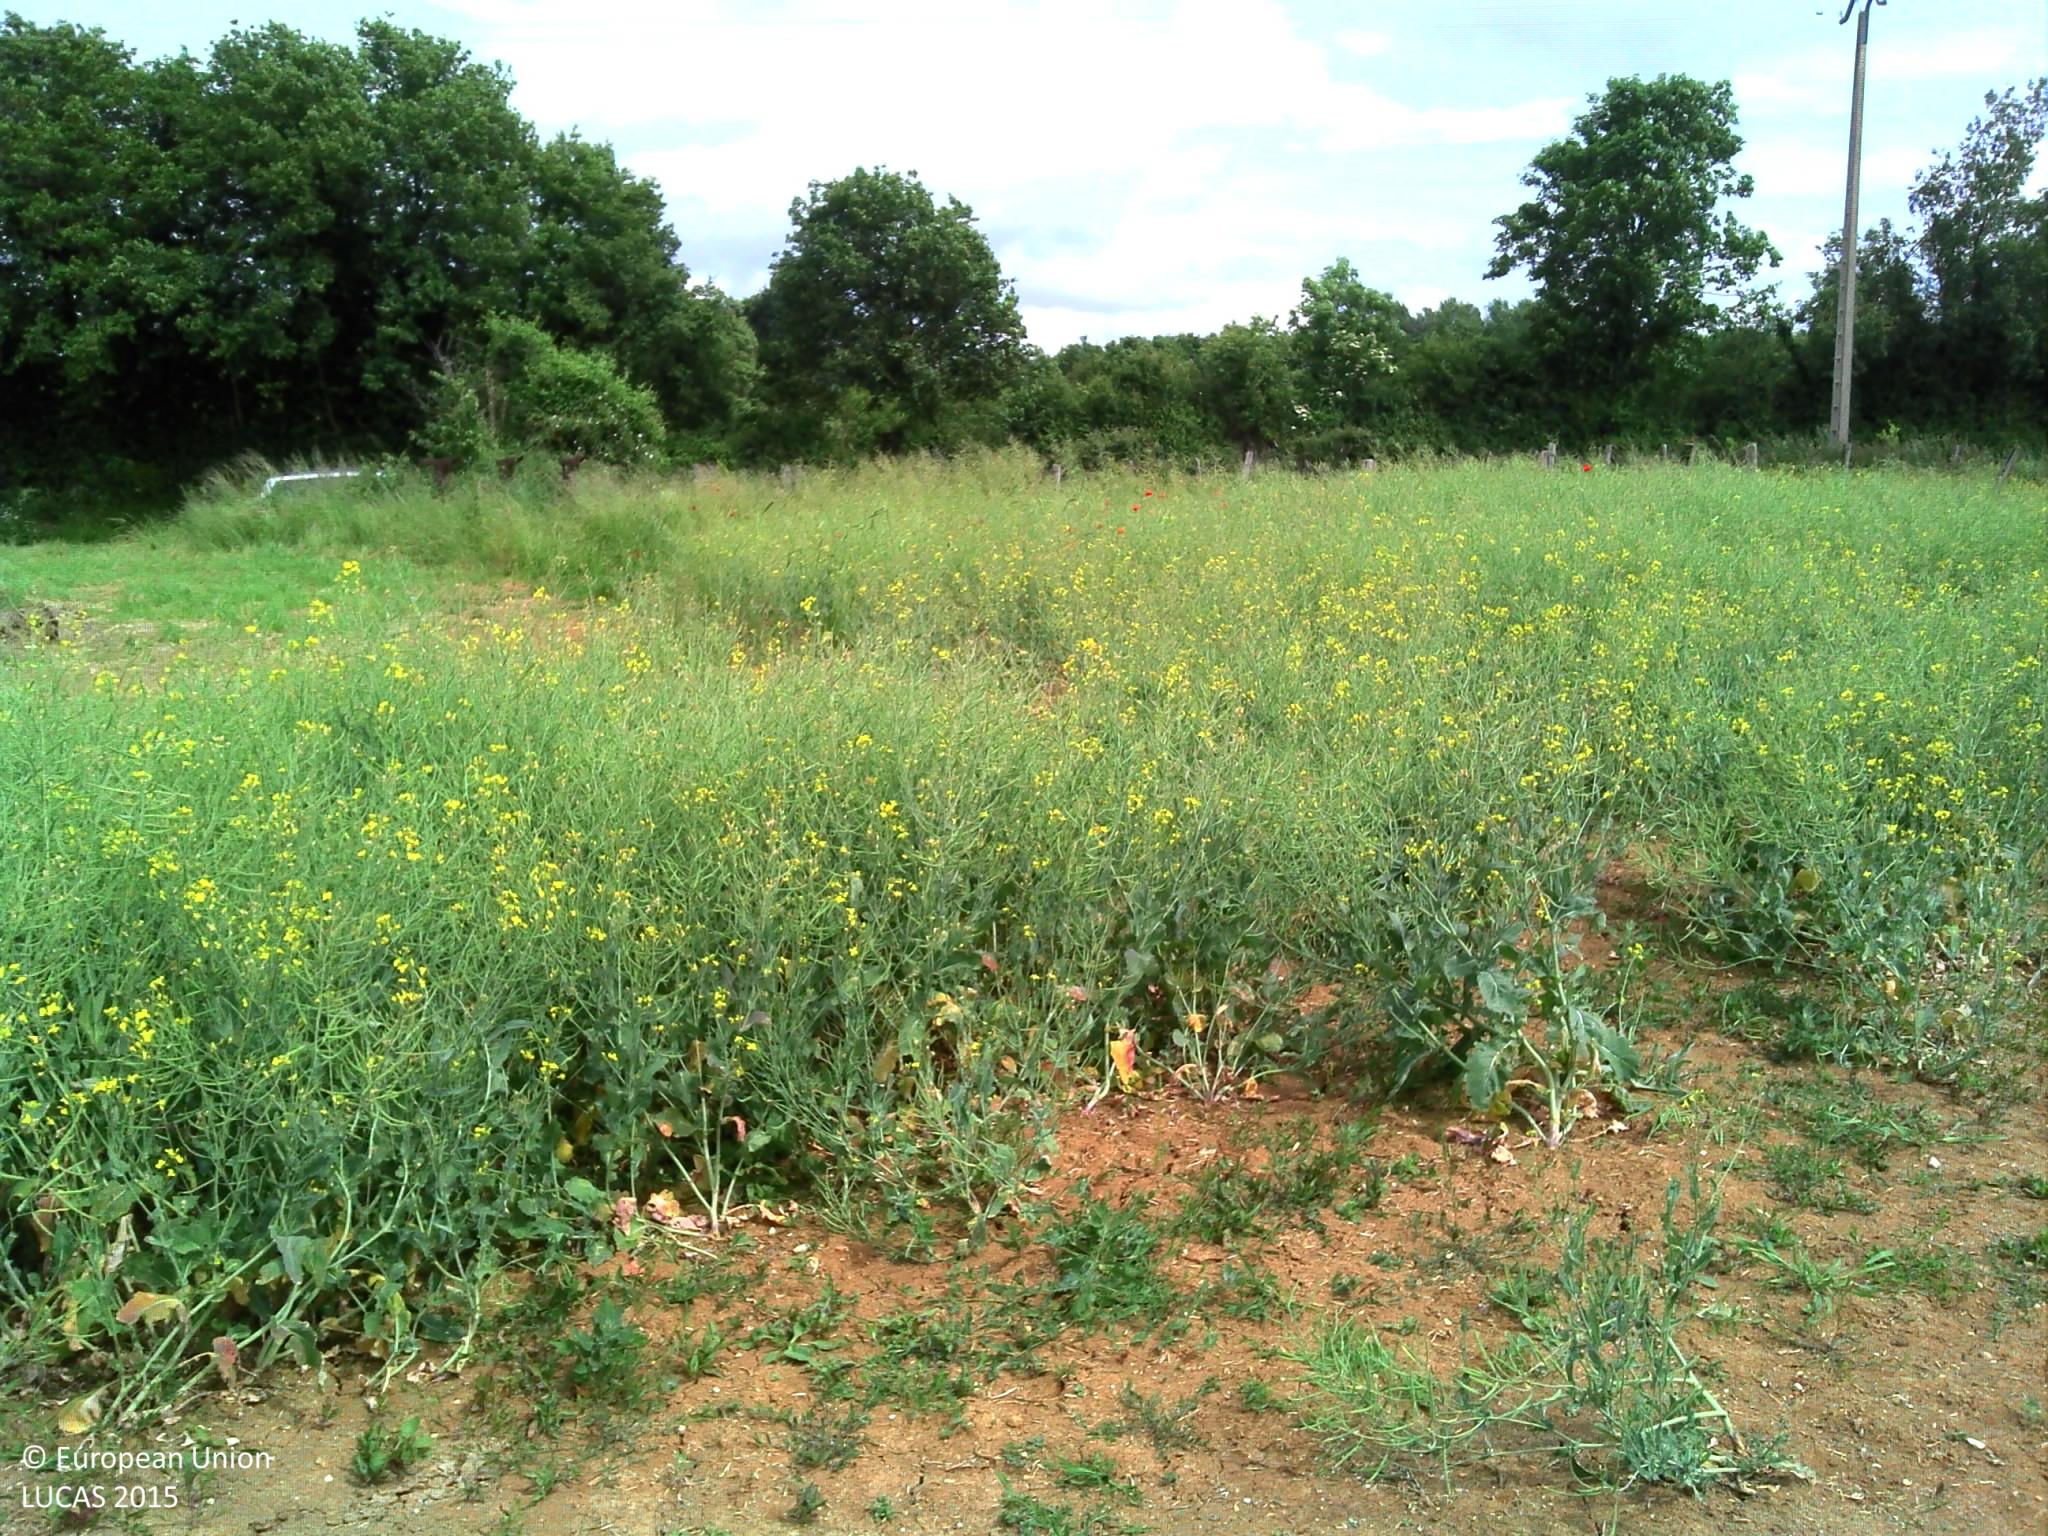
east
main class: Cropland
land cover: Rape and turnip rape
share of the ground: > 75 %
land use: Agriculture (excluding fallow land and kitchen gardens)
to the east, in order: Rape and turnip rape; Electric lines; Grass margins; Paved roads, cycling and walking lanes; Grass margins; Abandoned hedges; Grass margins; Tracks; Abandoned hedges; Barley
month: May
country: FR
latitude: 47.1104
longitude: 2.9183
